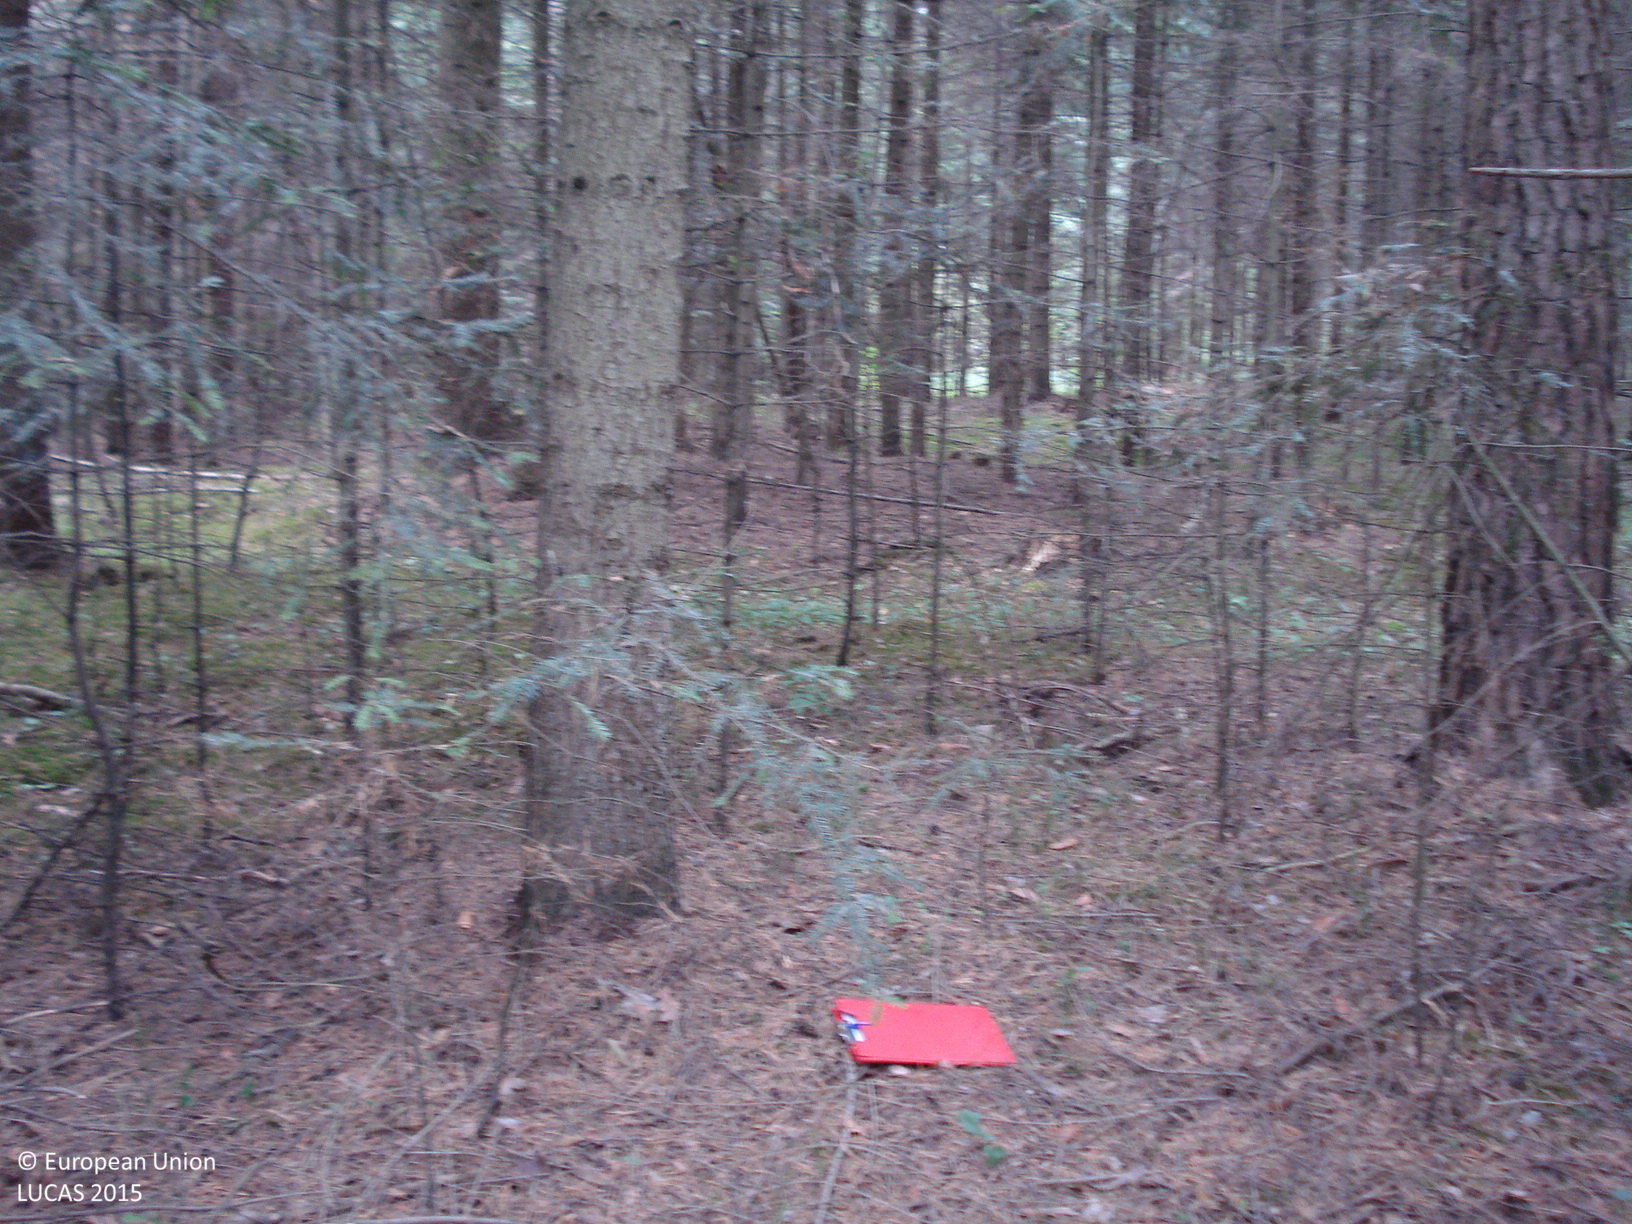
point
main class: Woodland
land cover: Spruce dominated coniferous woodland
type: hemiboreal forest and nemoral coniferous forest and mixed broadleaved-coniferous forest
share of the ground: > 75 %
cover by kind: coniferous forest trees 70 %, lichens and mosses 10 %, unconsolidated bare surface 10 %, broadleaved forest trees 5 %, herbaceous plants 5 %
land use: Forestry
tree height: > 5 m
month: September
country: PL
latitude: 50.8292
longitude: 20.8179
